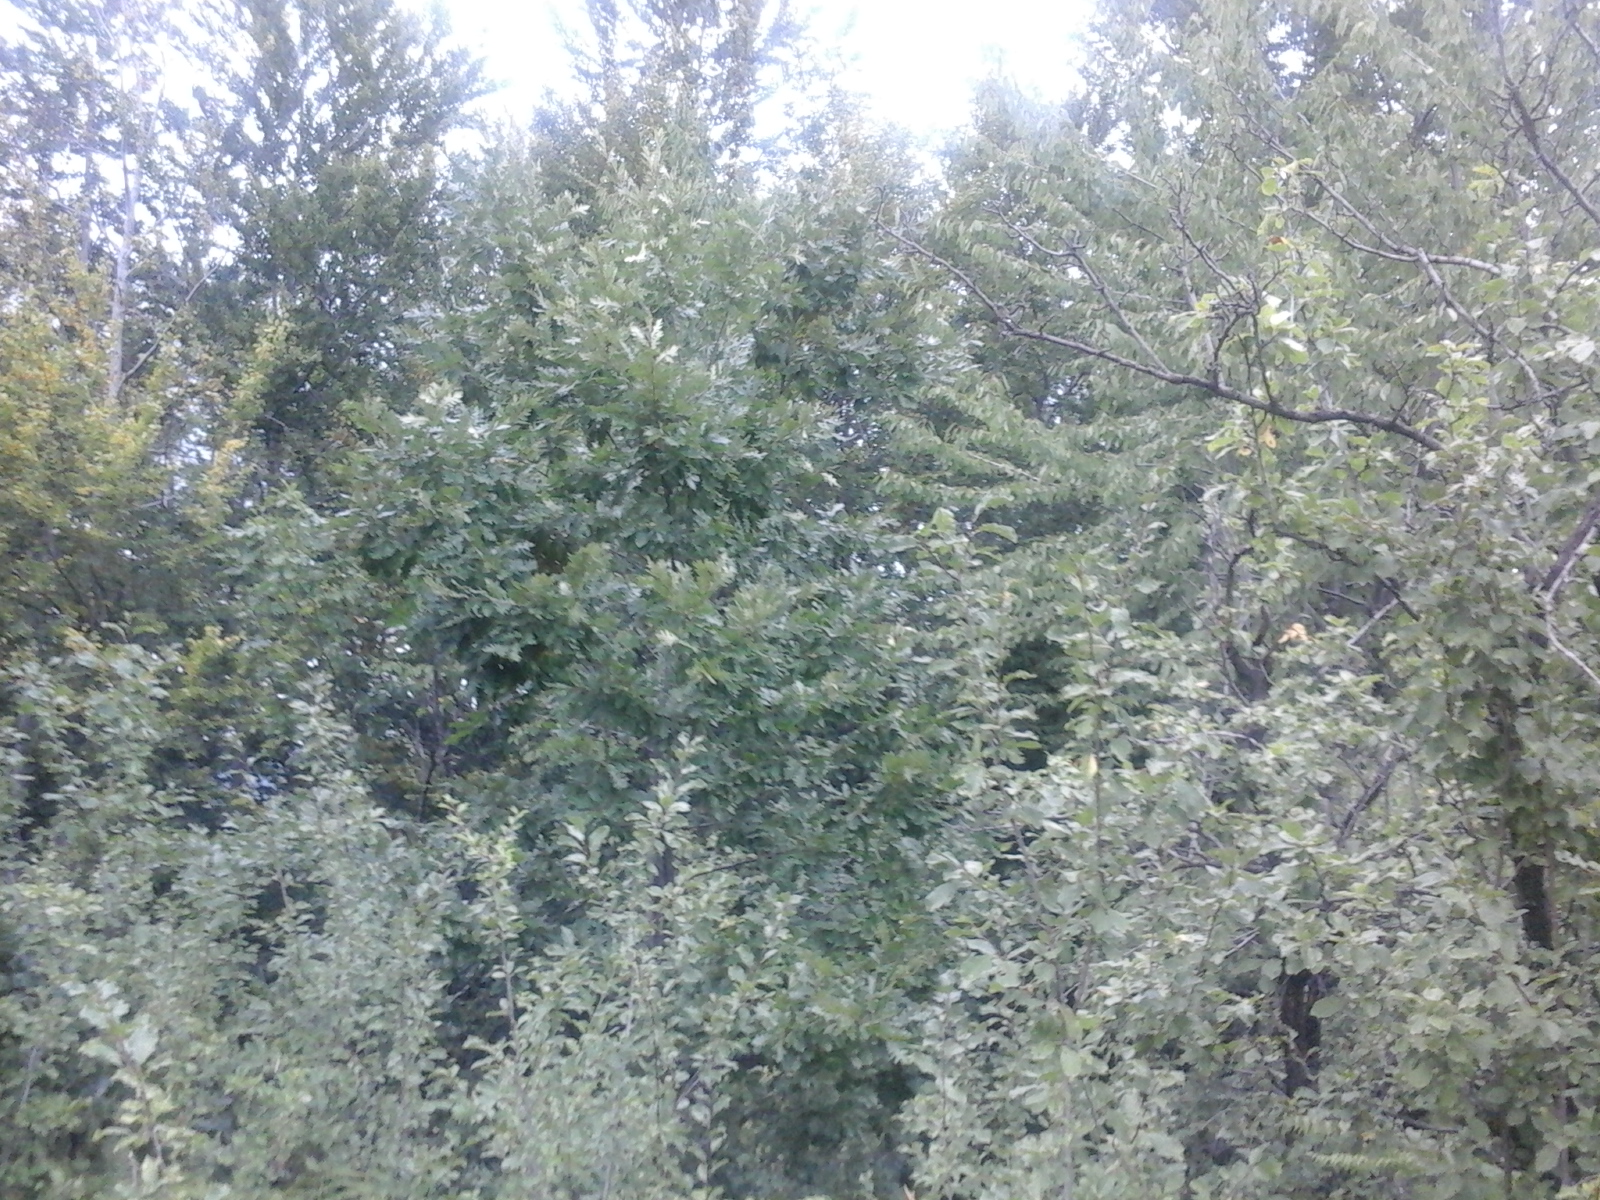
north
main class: Grassland
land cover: Grassland with sparse tree/shrub cover
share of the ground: > 75 %
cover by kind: herbaceous plants 95 %, broadleaved forest trees 5 %
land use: Agriculture (excluding fallow land and kitchen gardens)
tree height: > 5 m
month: August
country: RO
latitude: 44.9487
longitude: 22.7322
